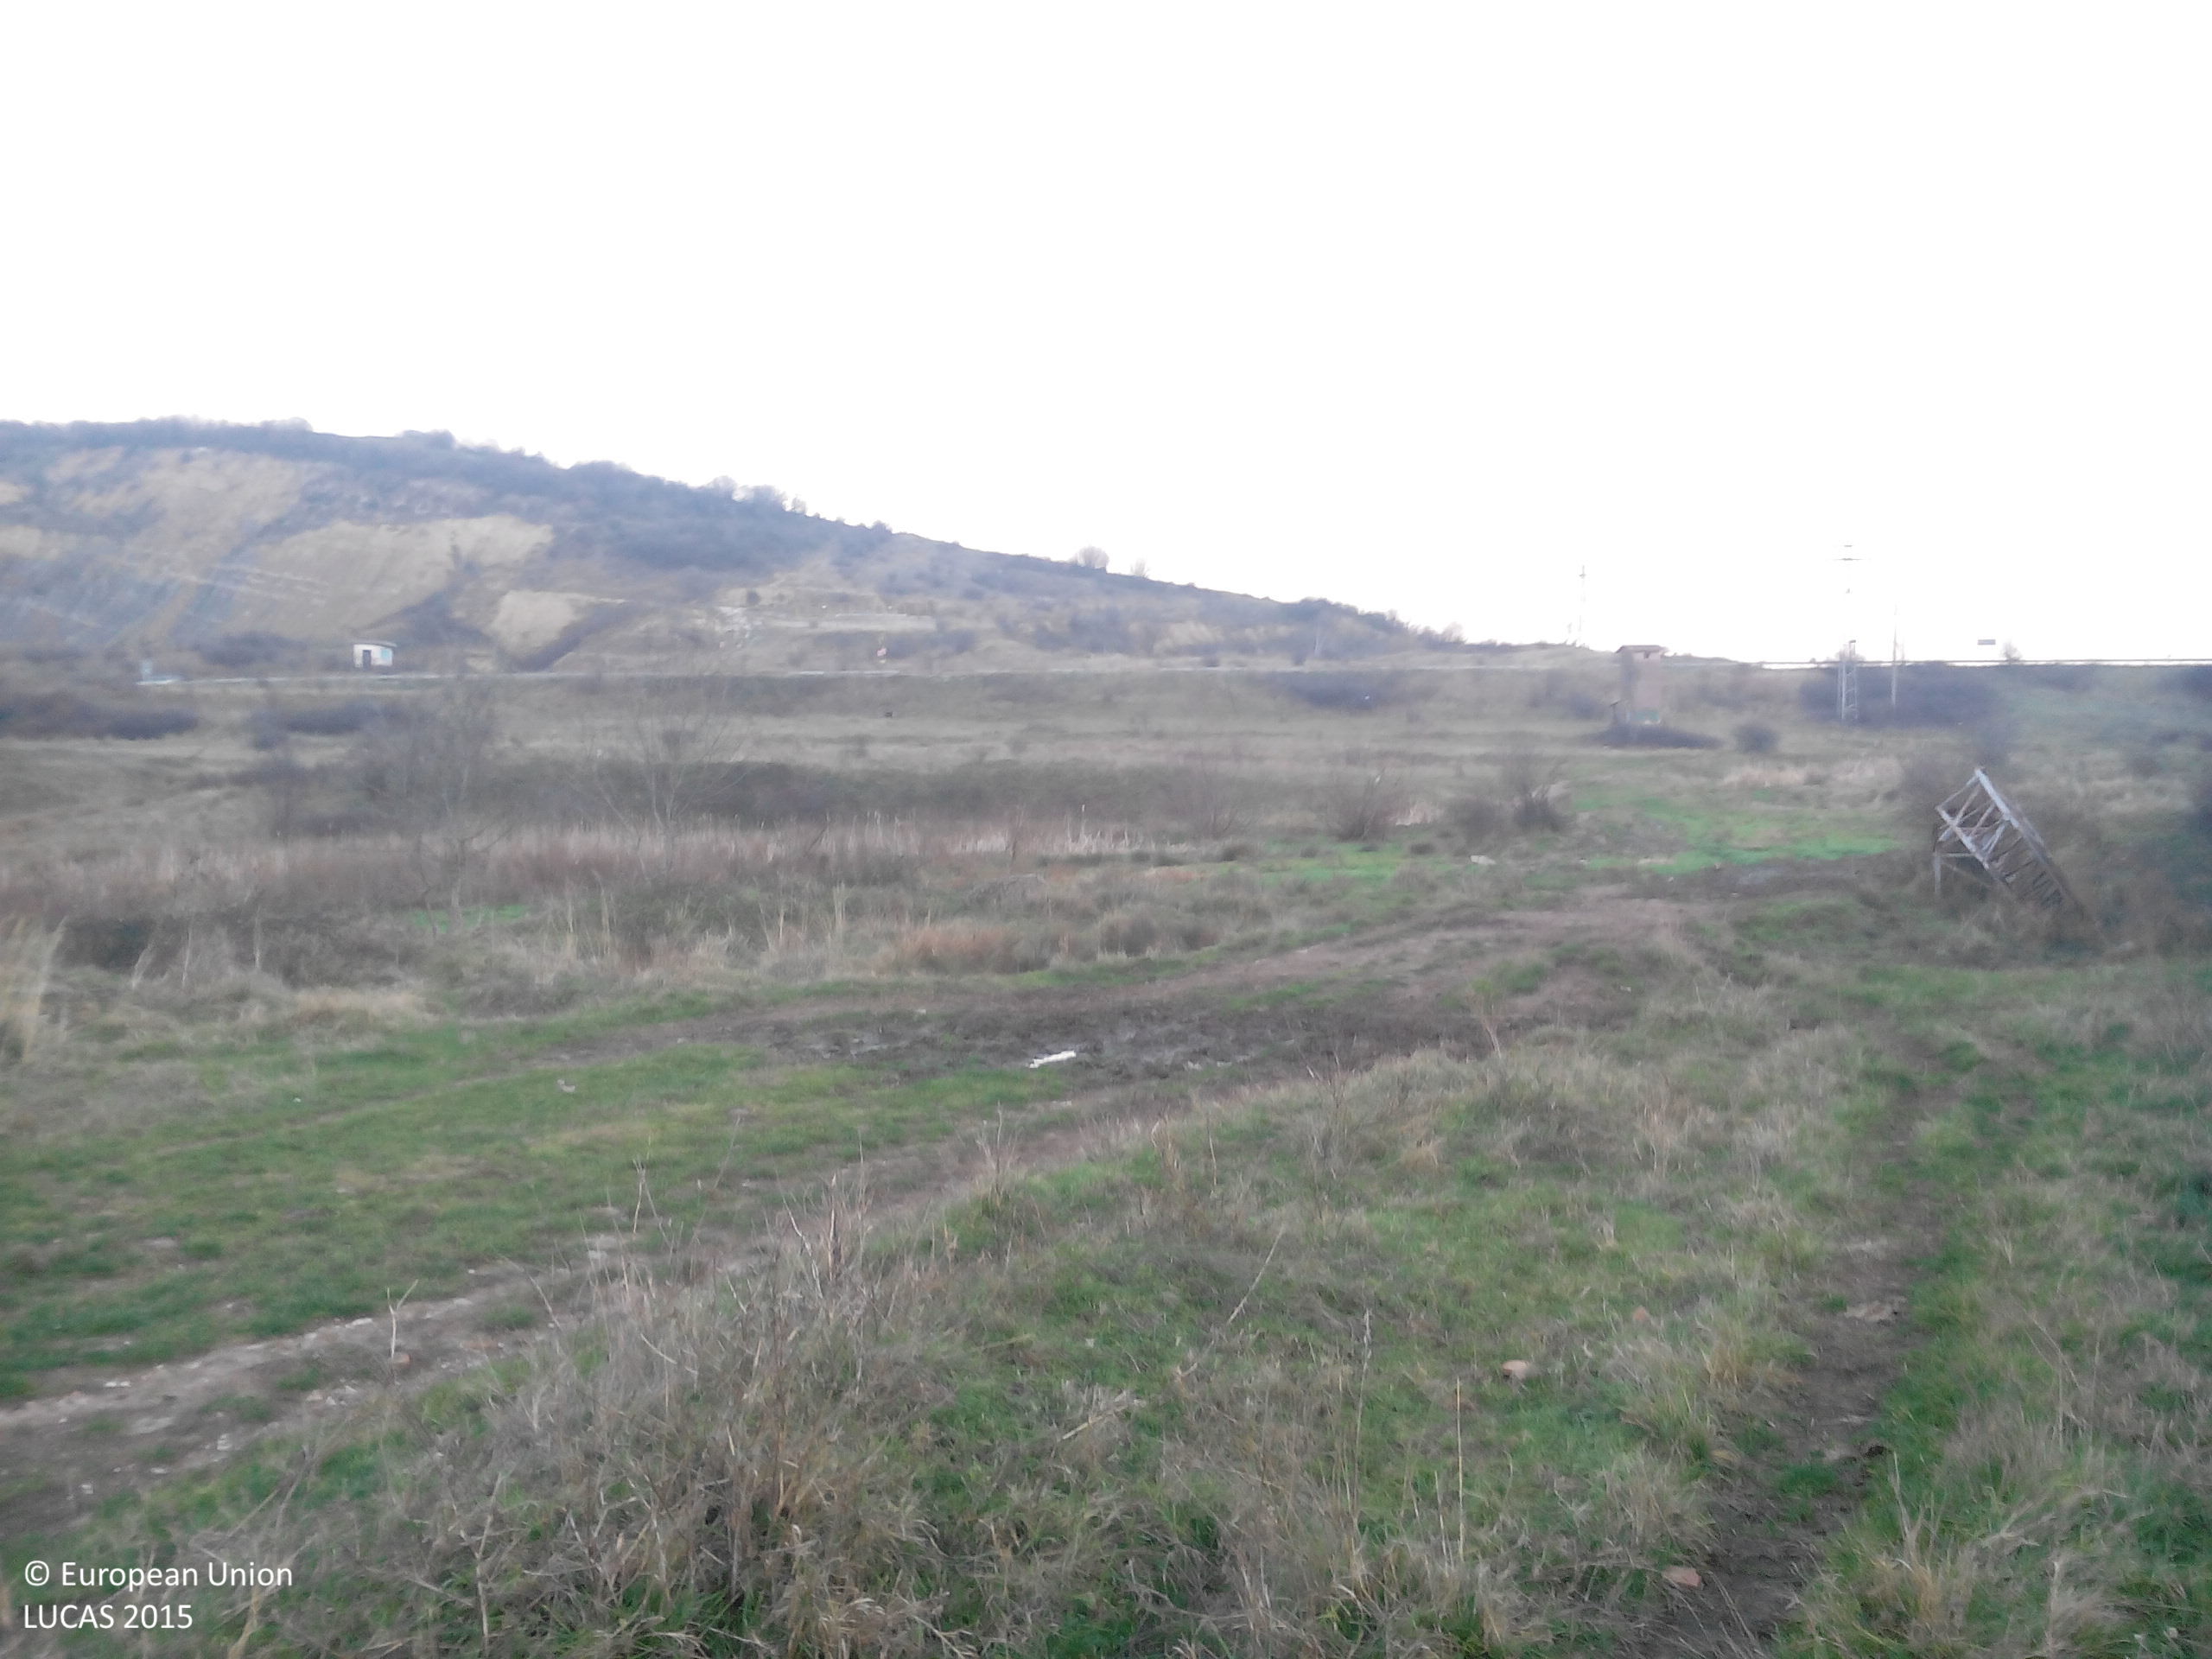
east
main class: Woodland
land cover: Broadleaved woodland
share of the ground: 25 - 50 %
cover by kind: shrubs 45 %, herbaceous plants 25 %, broadleaved forest trees 20 %, unconsolidated bare surface 10 %
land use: Machinery and equipment
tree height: < 5 m
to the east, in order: Broadleaved woodland; Fences; Electric lines; Grass margins; Tracks; Inland marshes; Grassland with sparse tree/shrub cover; Tracks; Grassland without tree/shrub cover; Paved roads, cycling and walking lanes; Grassland with sparse tree/shrub cover; Tracks; Grassland with sparse tree/shrub cover; Fences; Paved roads, cycling and walking lanes; Grassland with sparse tree/shrub cover
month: December
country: BG
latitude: 43.1957
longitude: 23.5919
